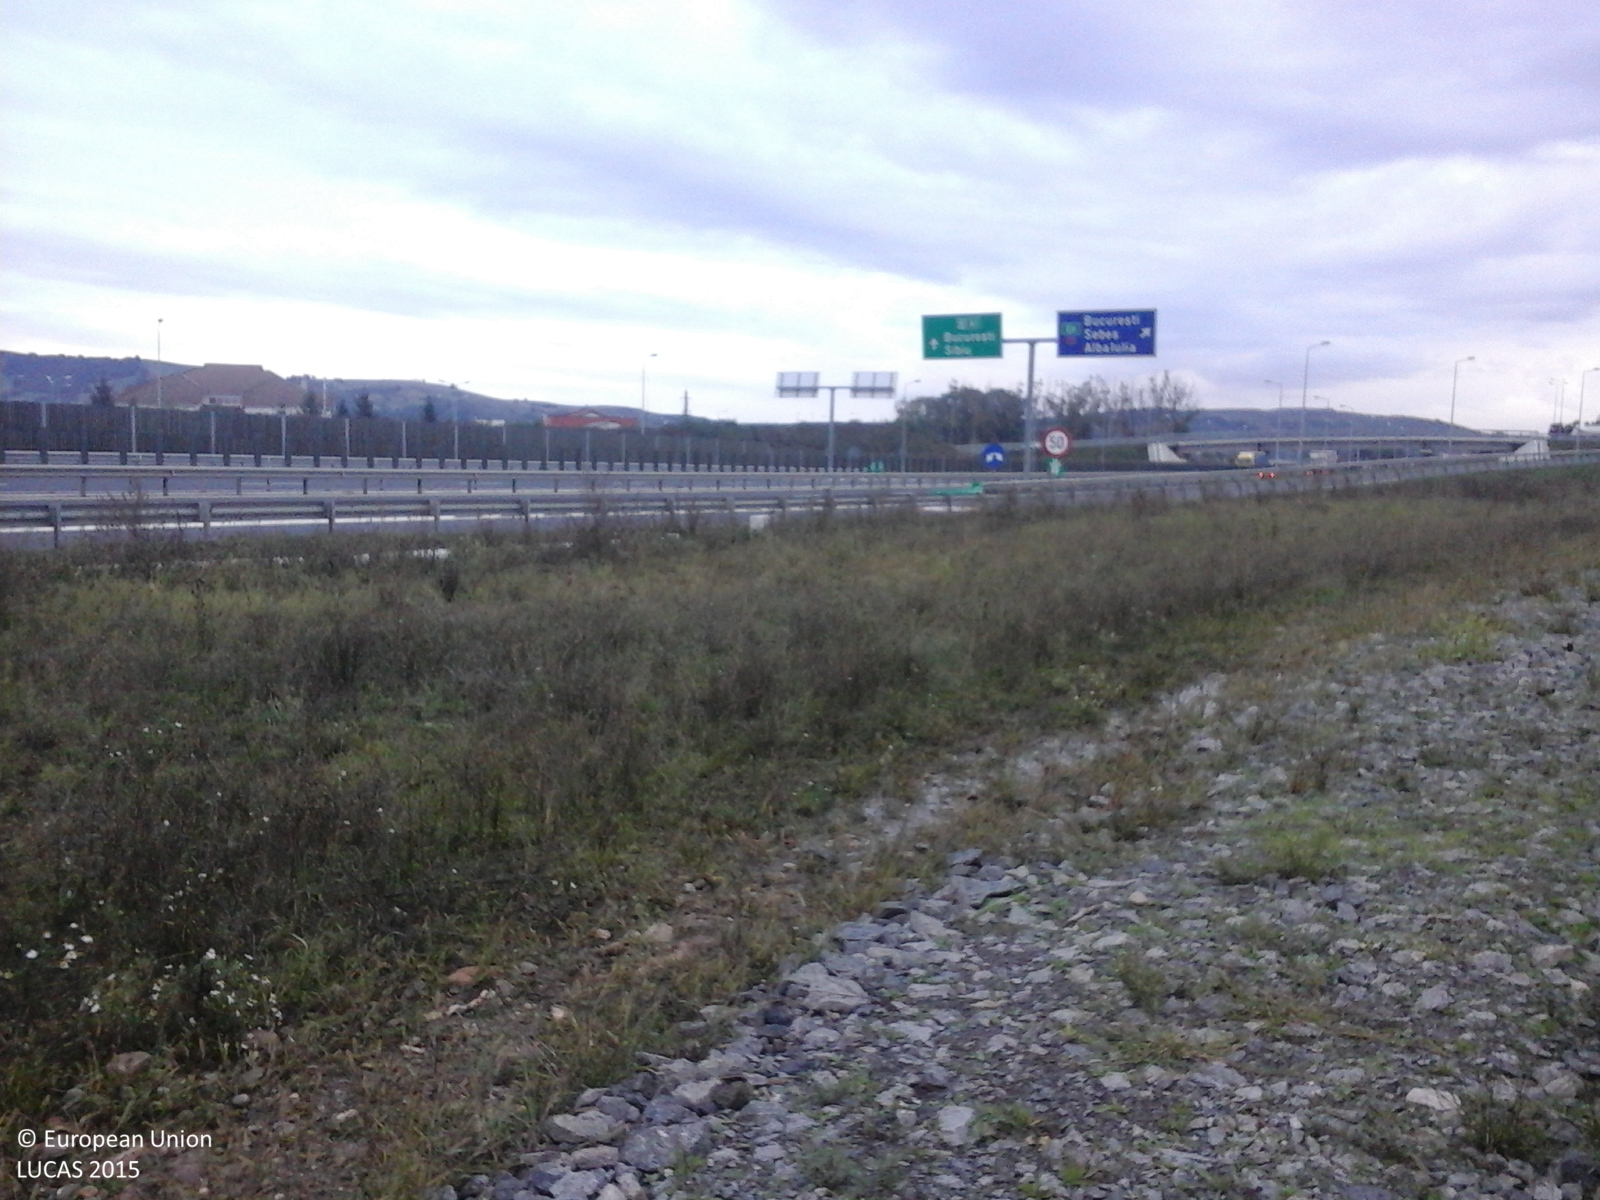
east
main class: Grassland
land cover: Grassland without tree/shrub cover
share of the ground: > 75 %
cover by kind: herbaceous plants 100 %
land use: Agriculture (excluding fallow land and kitchen gardens)
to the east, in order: Grassland without tree/shrub cover; Electric lines; Grassland without tree/shrub cover; Fences; Grassland without tree/shrub cover; Ditches and canals; Paved roads, cycling and walking lanes; Grassland without tree/shrub cover; Fences; Spontaneously vegetated surfaces; Artificial constructions in urban areas
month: September
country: RO
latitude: 45.9767
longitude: 23.5531
